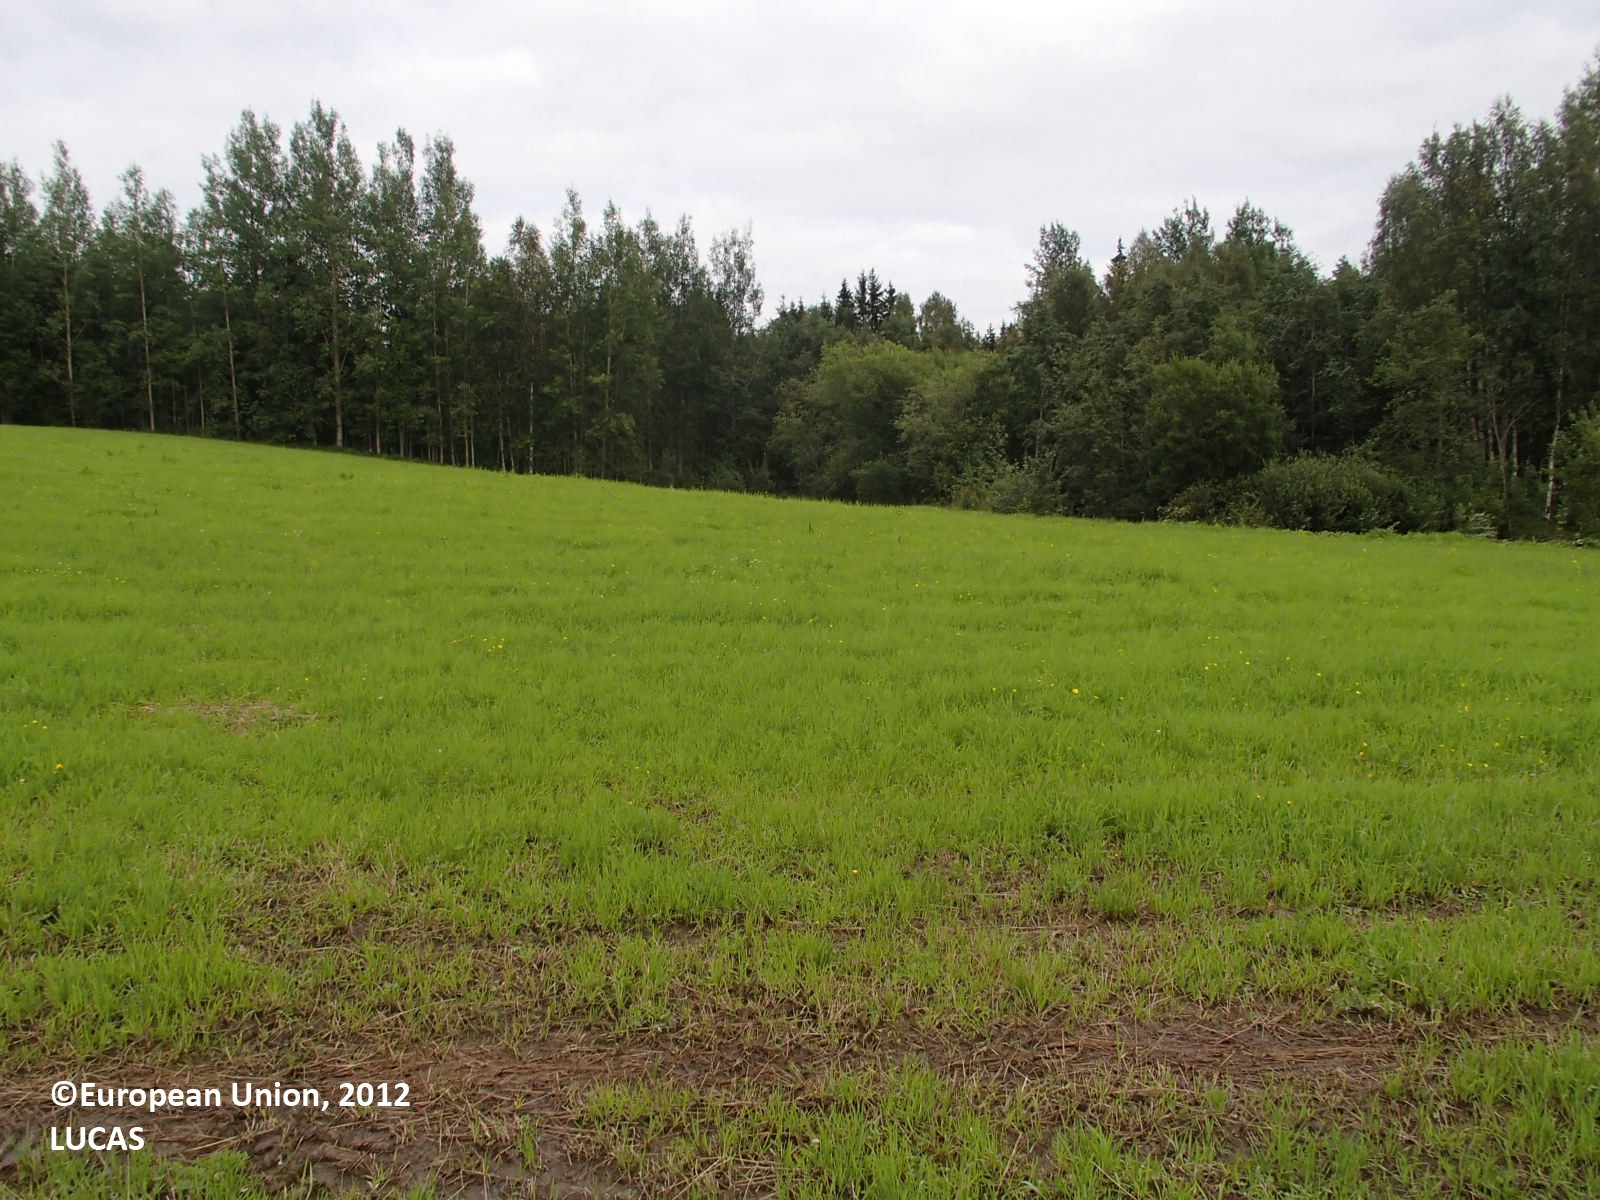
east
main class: Cropland
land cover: Oats
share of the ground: > 75 %
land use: Agriculture (excluding fallow land and kitchen gardens)
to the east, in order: Oats; Ditches and canals; Grass margins; Tracks; Temporary grasslands; Broadleaved woodland; Pine dominated mixed woodland; Rivers and streams; Spruce dominated mixed woodland; Shrubland without tree cover; Broadleaved woodland; Pine dominated mixed woodland
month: August
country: FI
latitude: 63.7379
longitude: 27.2623
